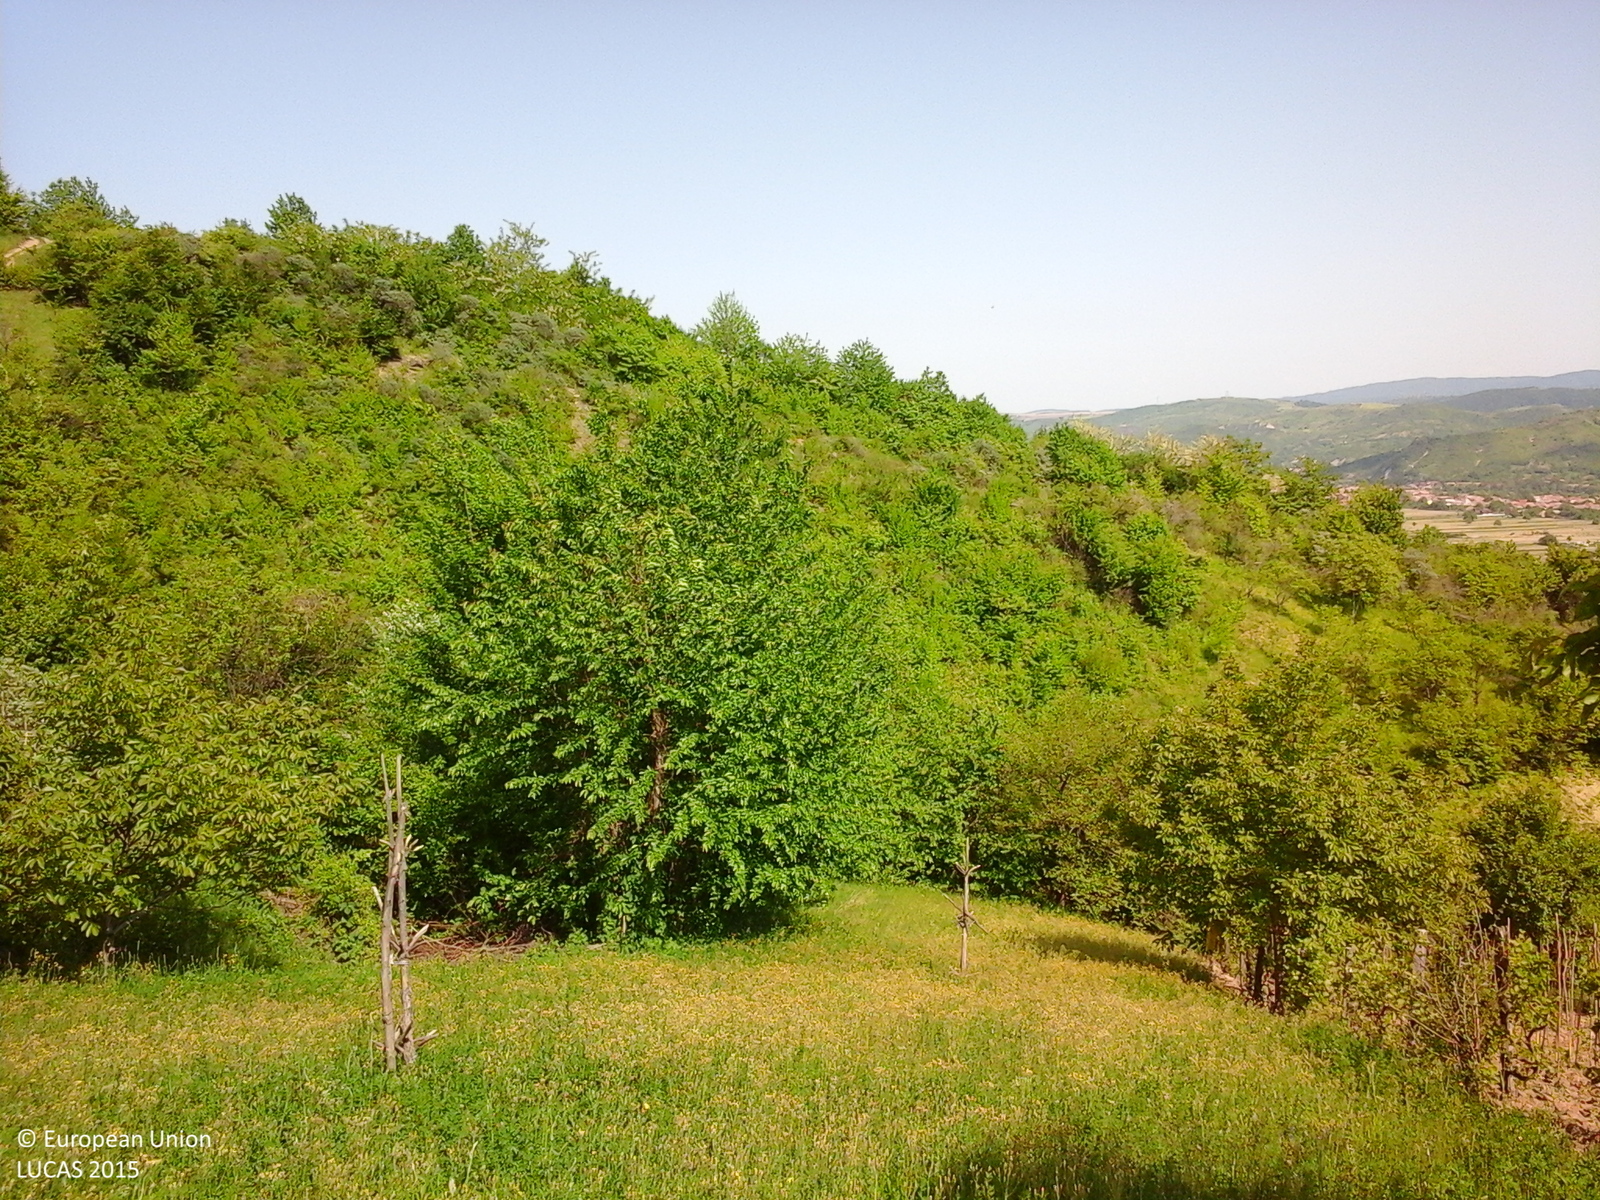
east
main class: Cropland
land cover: Other leguminous and mixtures for fodder
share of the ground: > 75 %
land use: Agriculture (excluding fallow land and kitchen gardens)
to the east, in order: Other leguminous and mixtures for fodder; Cherry fruit; Broadleaved woodland; Rivers and streams; Broadleaved woodland; Tracks; Broadleaved woodland; Grassland with sparse tree/shrub cover; Lines of trees; Arable land (only in case pi); Lines of trees; Arable land (only in case pi); Lines of trees; Shrubland with sparse tree cover; Broadleaved woodland
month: May
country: RO
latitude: 46.2167
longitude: 26.6109
